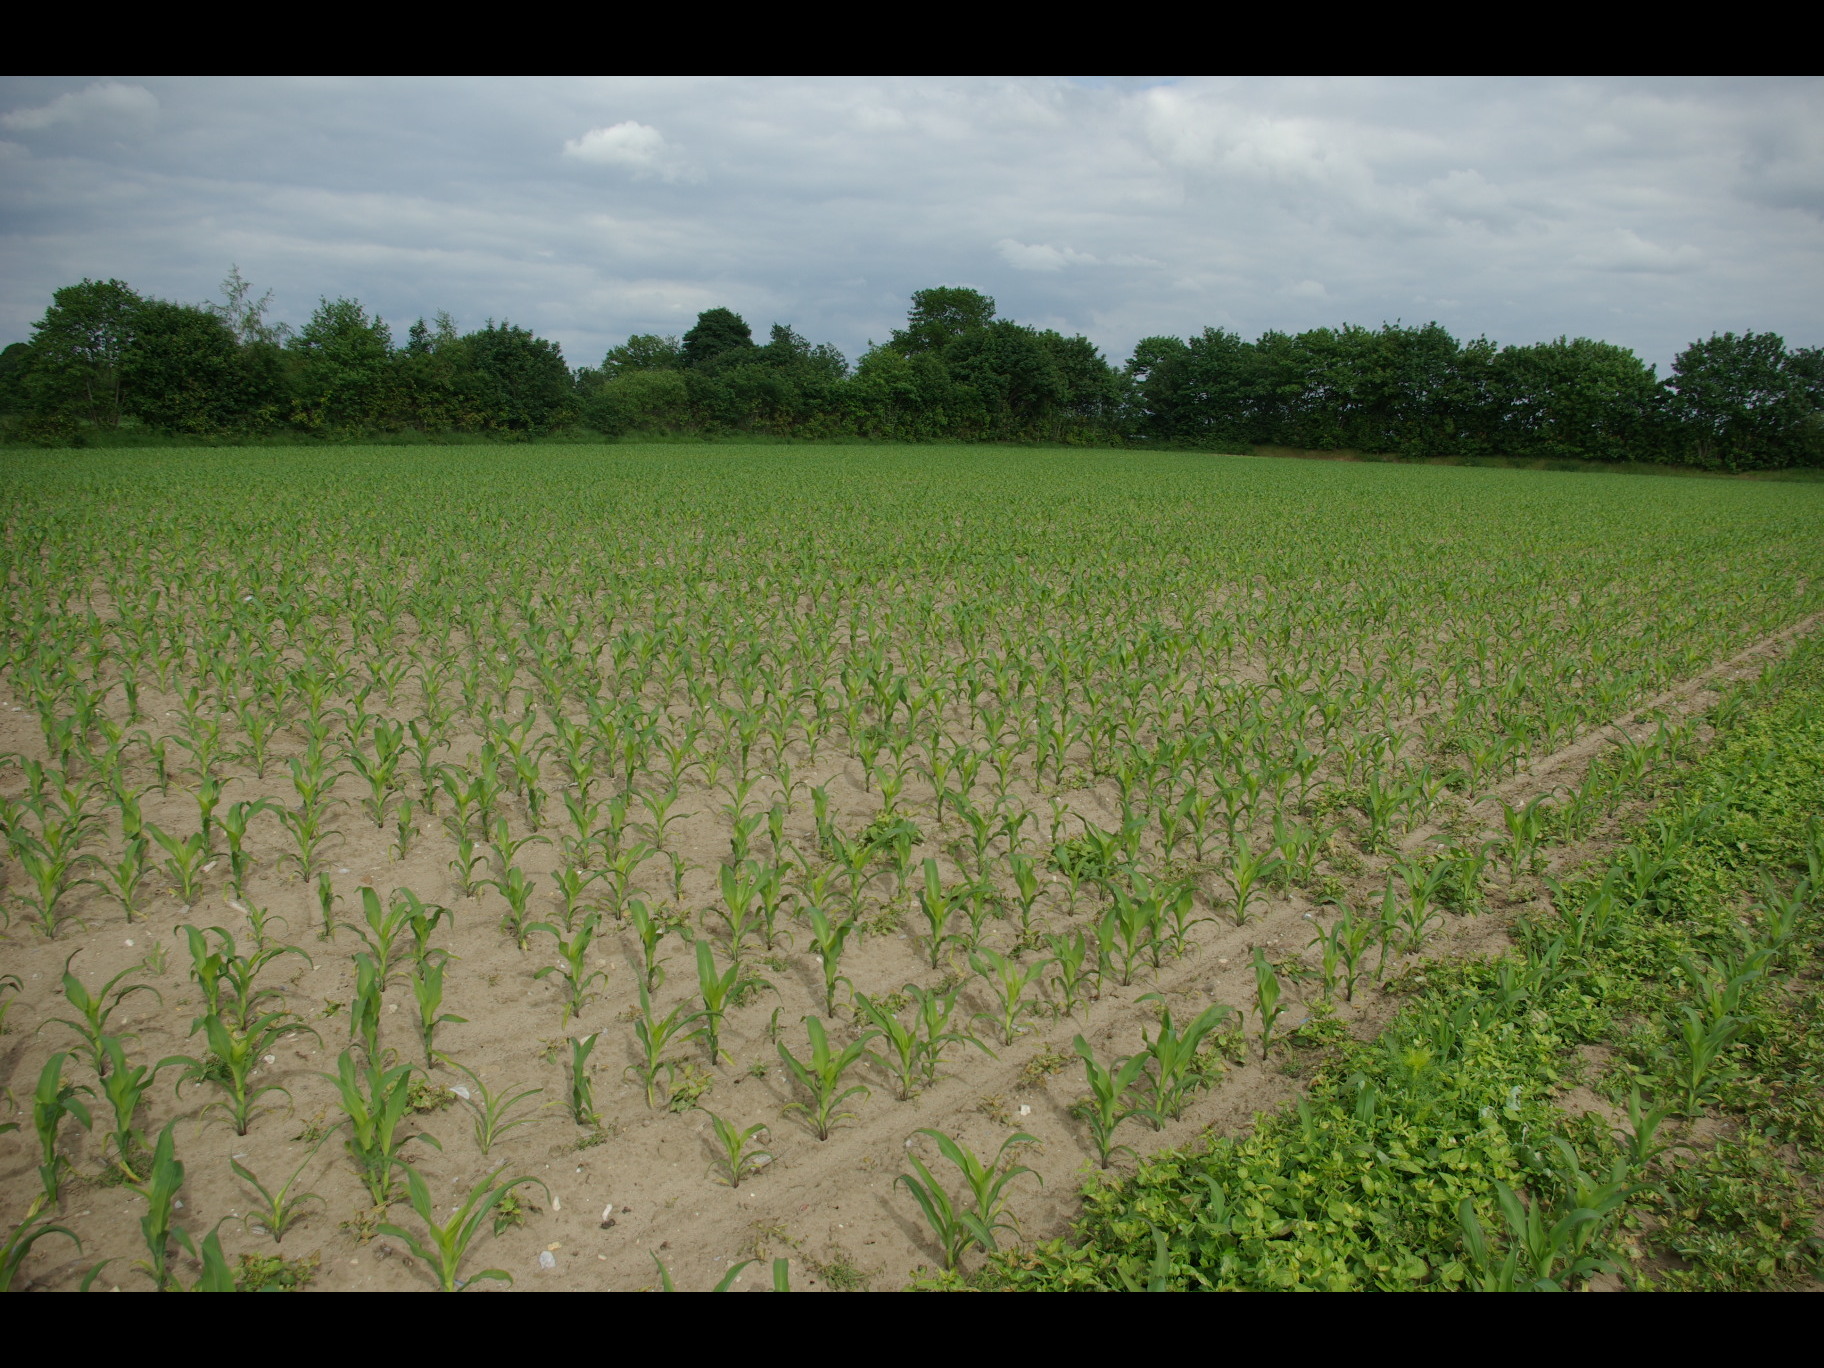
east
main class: Cropland
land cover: Maize
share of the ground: 25 - 50 %
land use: Agriculture (excluding fallow land and kitchen gardens)
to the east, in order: Maize; Broadleaved woodland; Maize; Broadleaved woodland; Shruby margins; Paved roads, cycling and walking lanes; Lines of trees; Grass margins; Paved roads, cycling and walking lanes; Grass margins; Ditches and canals; Broadleaved woodland; Fences; Grassland without tree/shrub cover; Fences; Shrubland with sparse tree cover; Maize
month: June
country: DE
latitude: 54.1387
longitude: 9.8317
